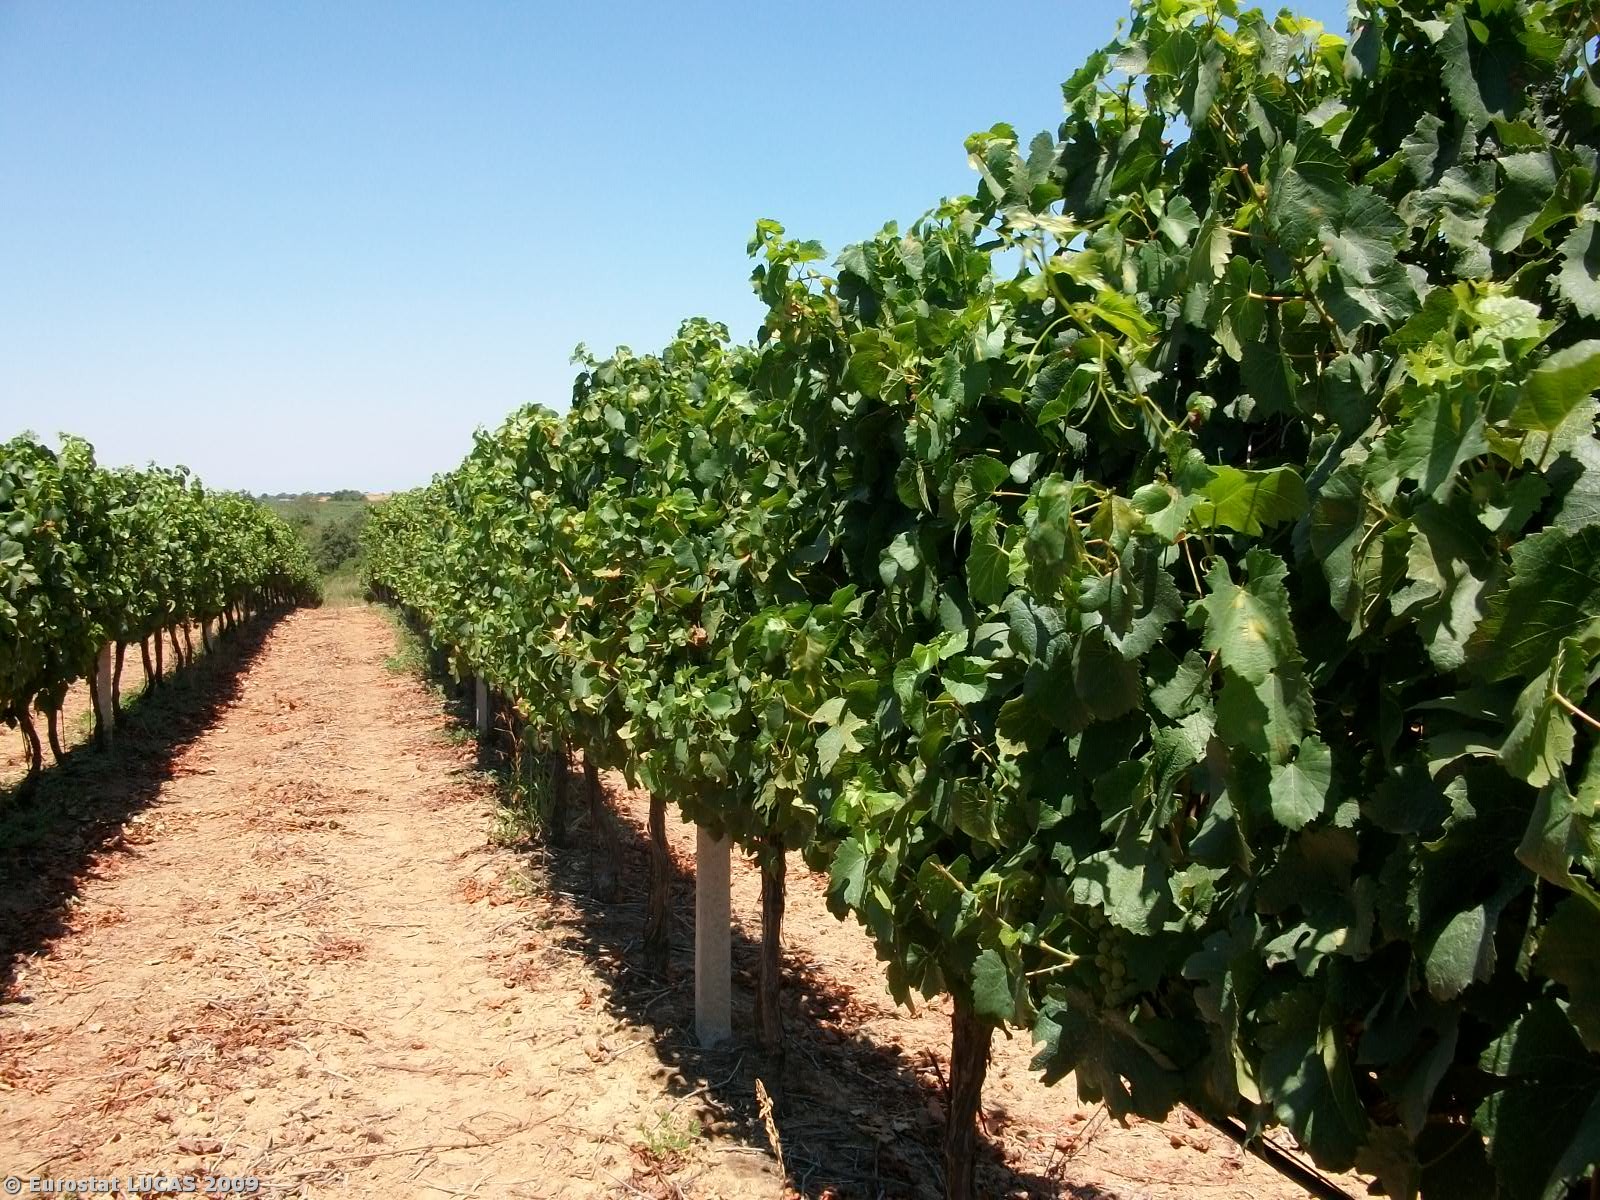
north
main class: Cropland
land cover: Vineyards
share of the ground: 50 - 75 %
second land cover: Bare land
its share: 50 - 75 %
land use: Agriculture (excluding fallow land and kitchen gardens)
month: July
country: GR
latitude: 37.9175
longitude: 21.4164
